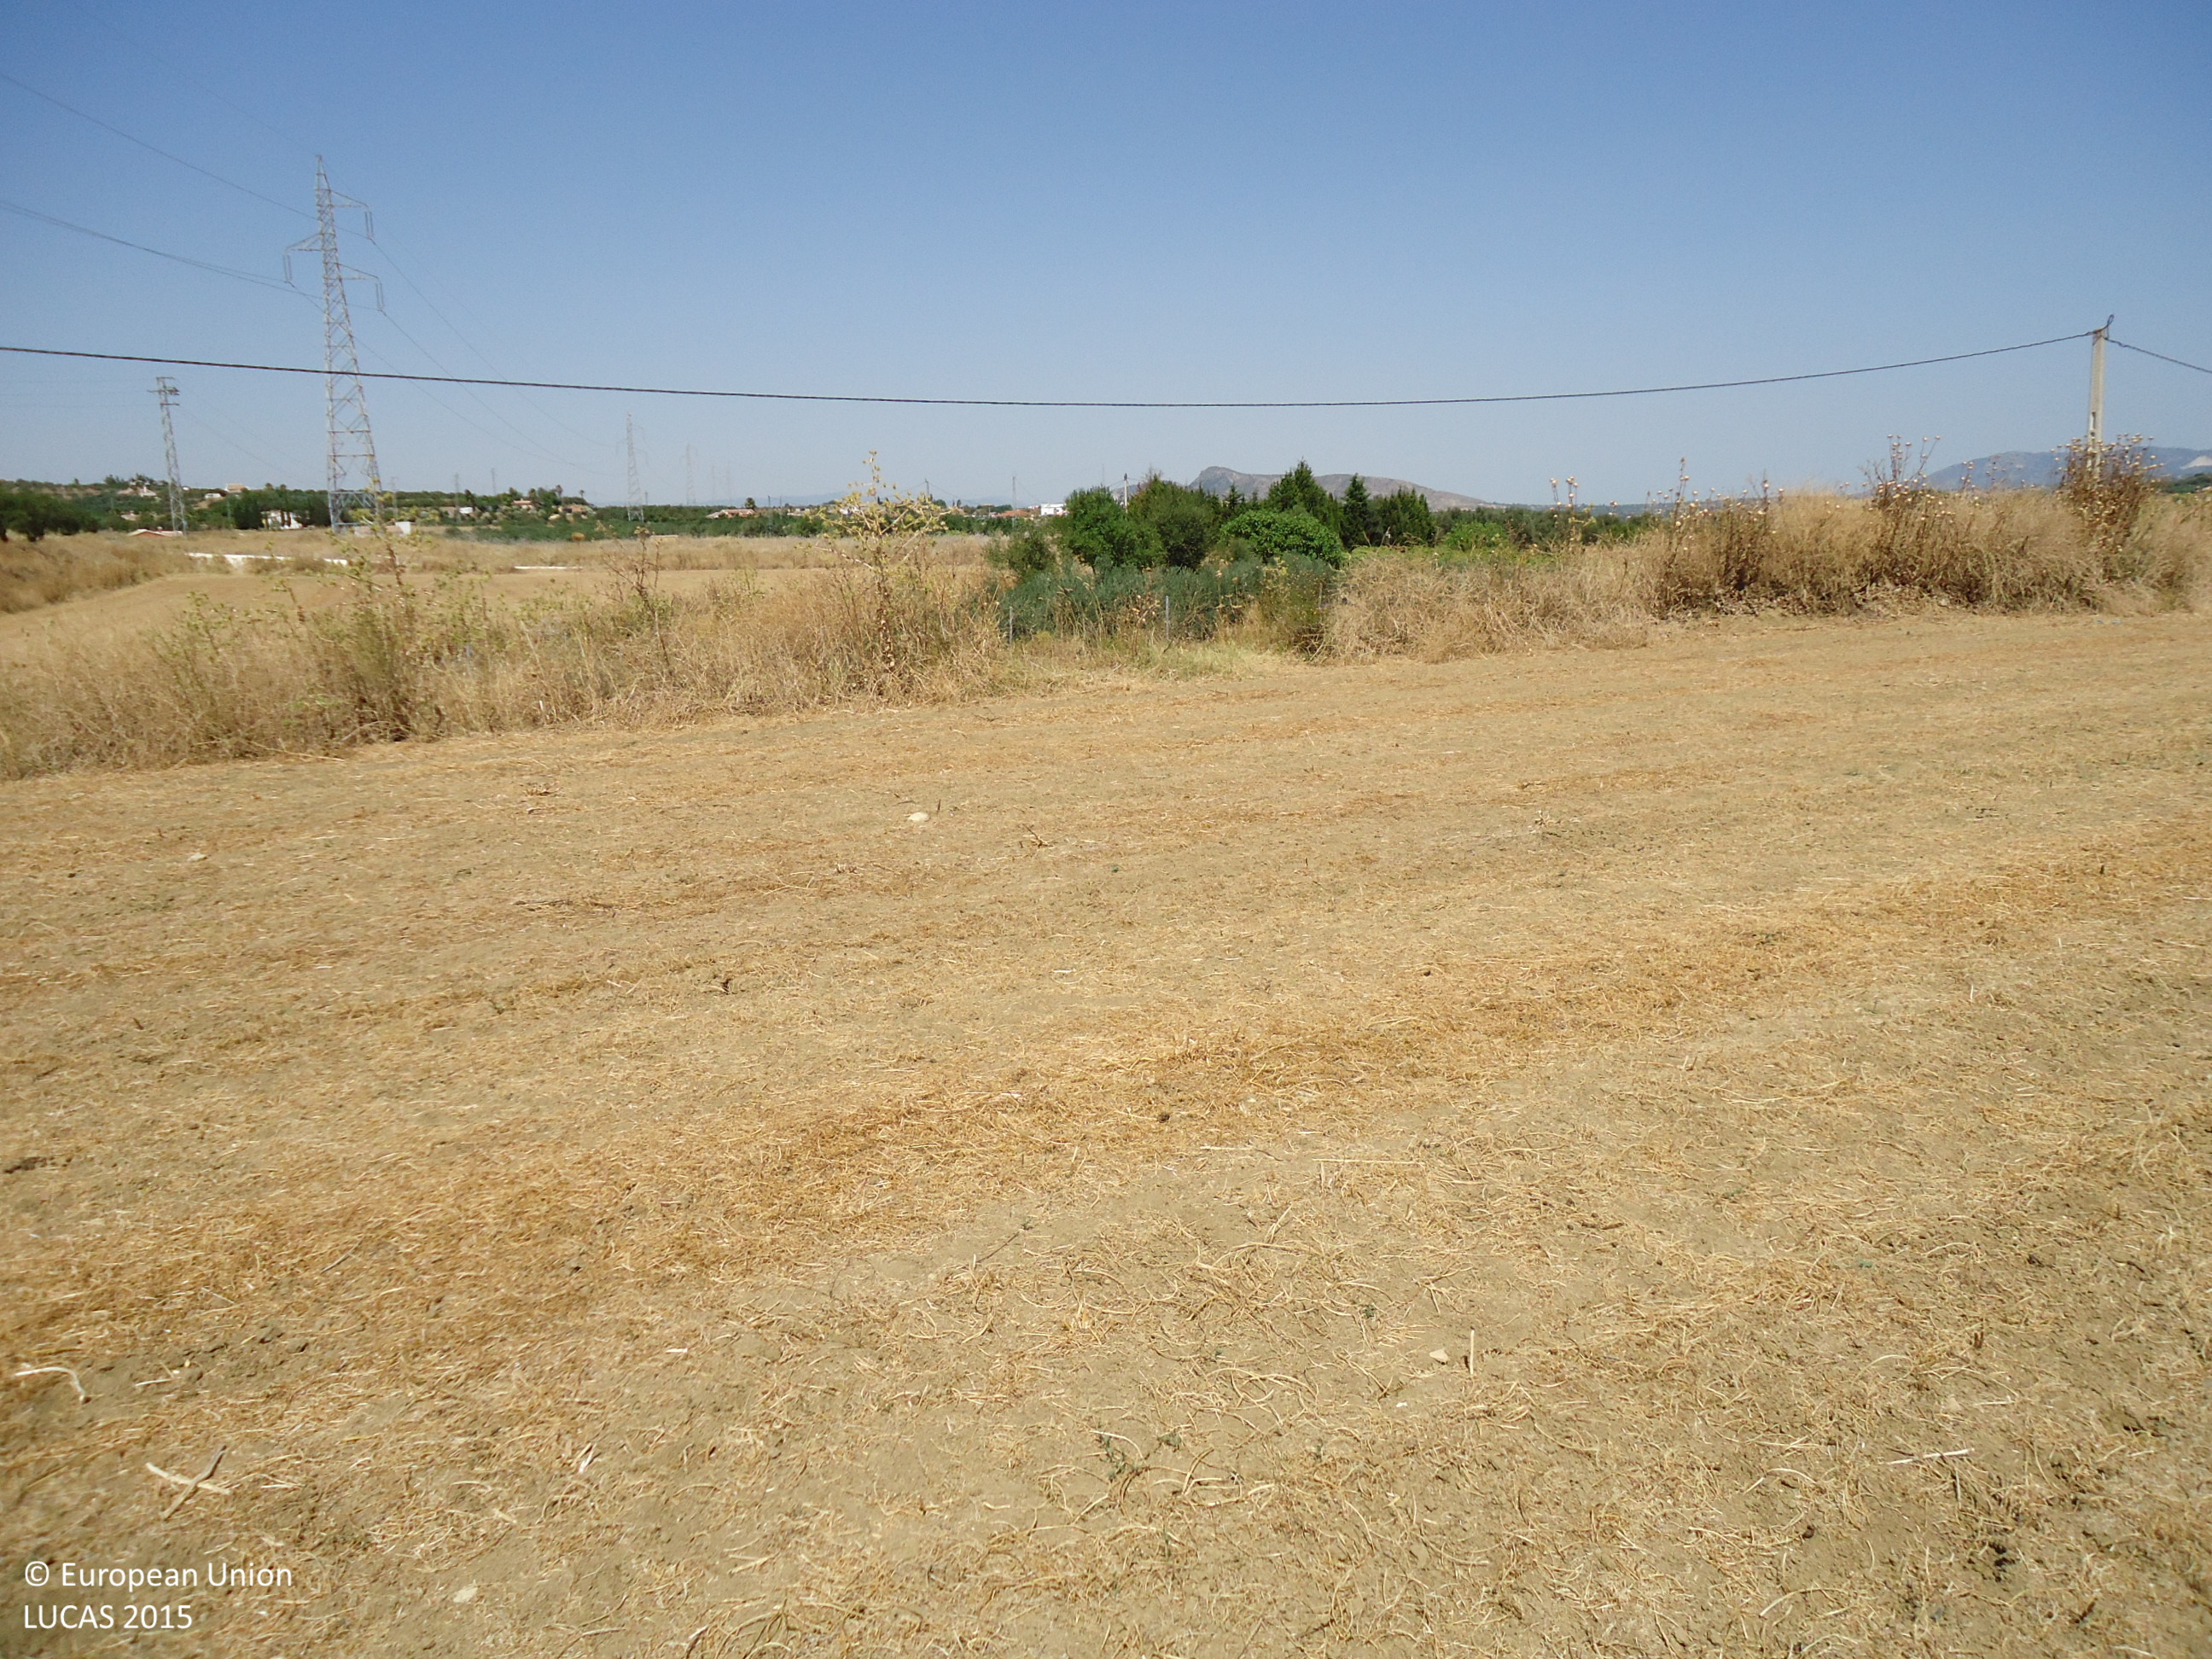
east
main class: Grassland
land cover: Spontaneously vegetated surfaces
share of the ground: > 75 %
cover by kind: herbaceous plants 90 %, unconsolidated bare surface 10 %
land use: Agriculture (excluding fallow land and kitchen gardens)
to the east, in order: Spontaneously vegetated surfaces; Grass margins; Tracks; Grass margins; Electric lines; Fences; Rivers and streams; Olive groves; Other bare soil; Fences; Tracks; Fences; Electric lines; Oranges; Fences; Olive groves; Fences; Durum wheat
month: June
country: ES
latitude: 36.6854
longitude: -4.7314
